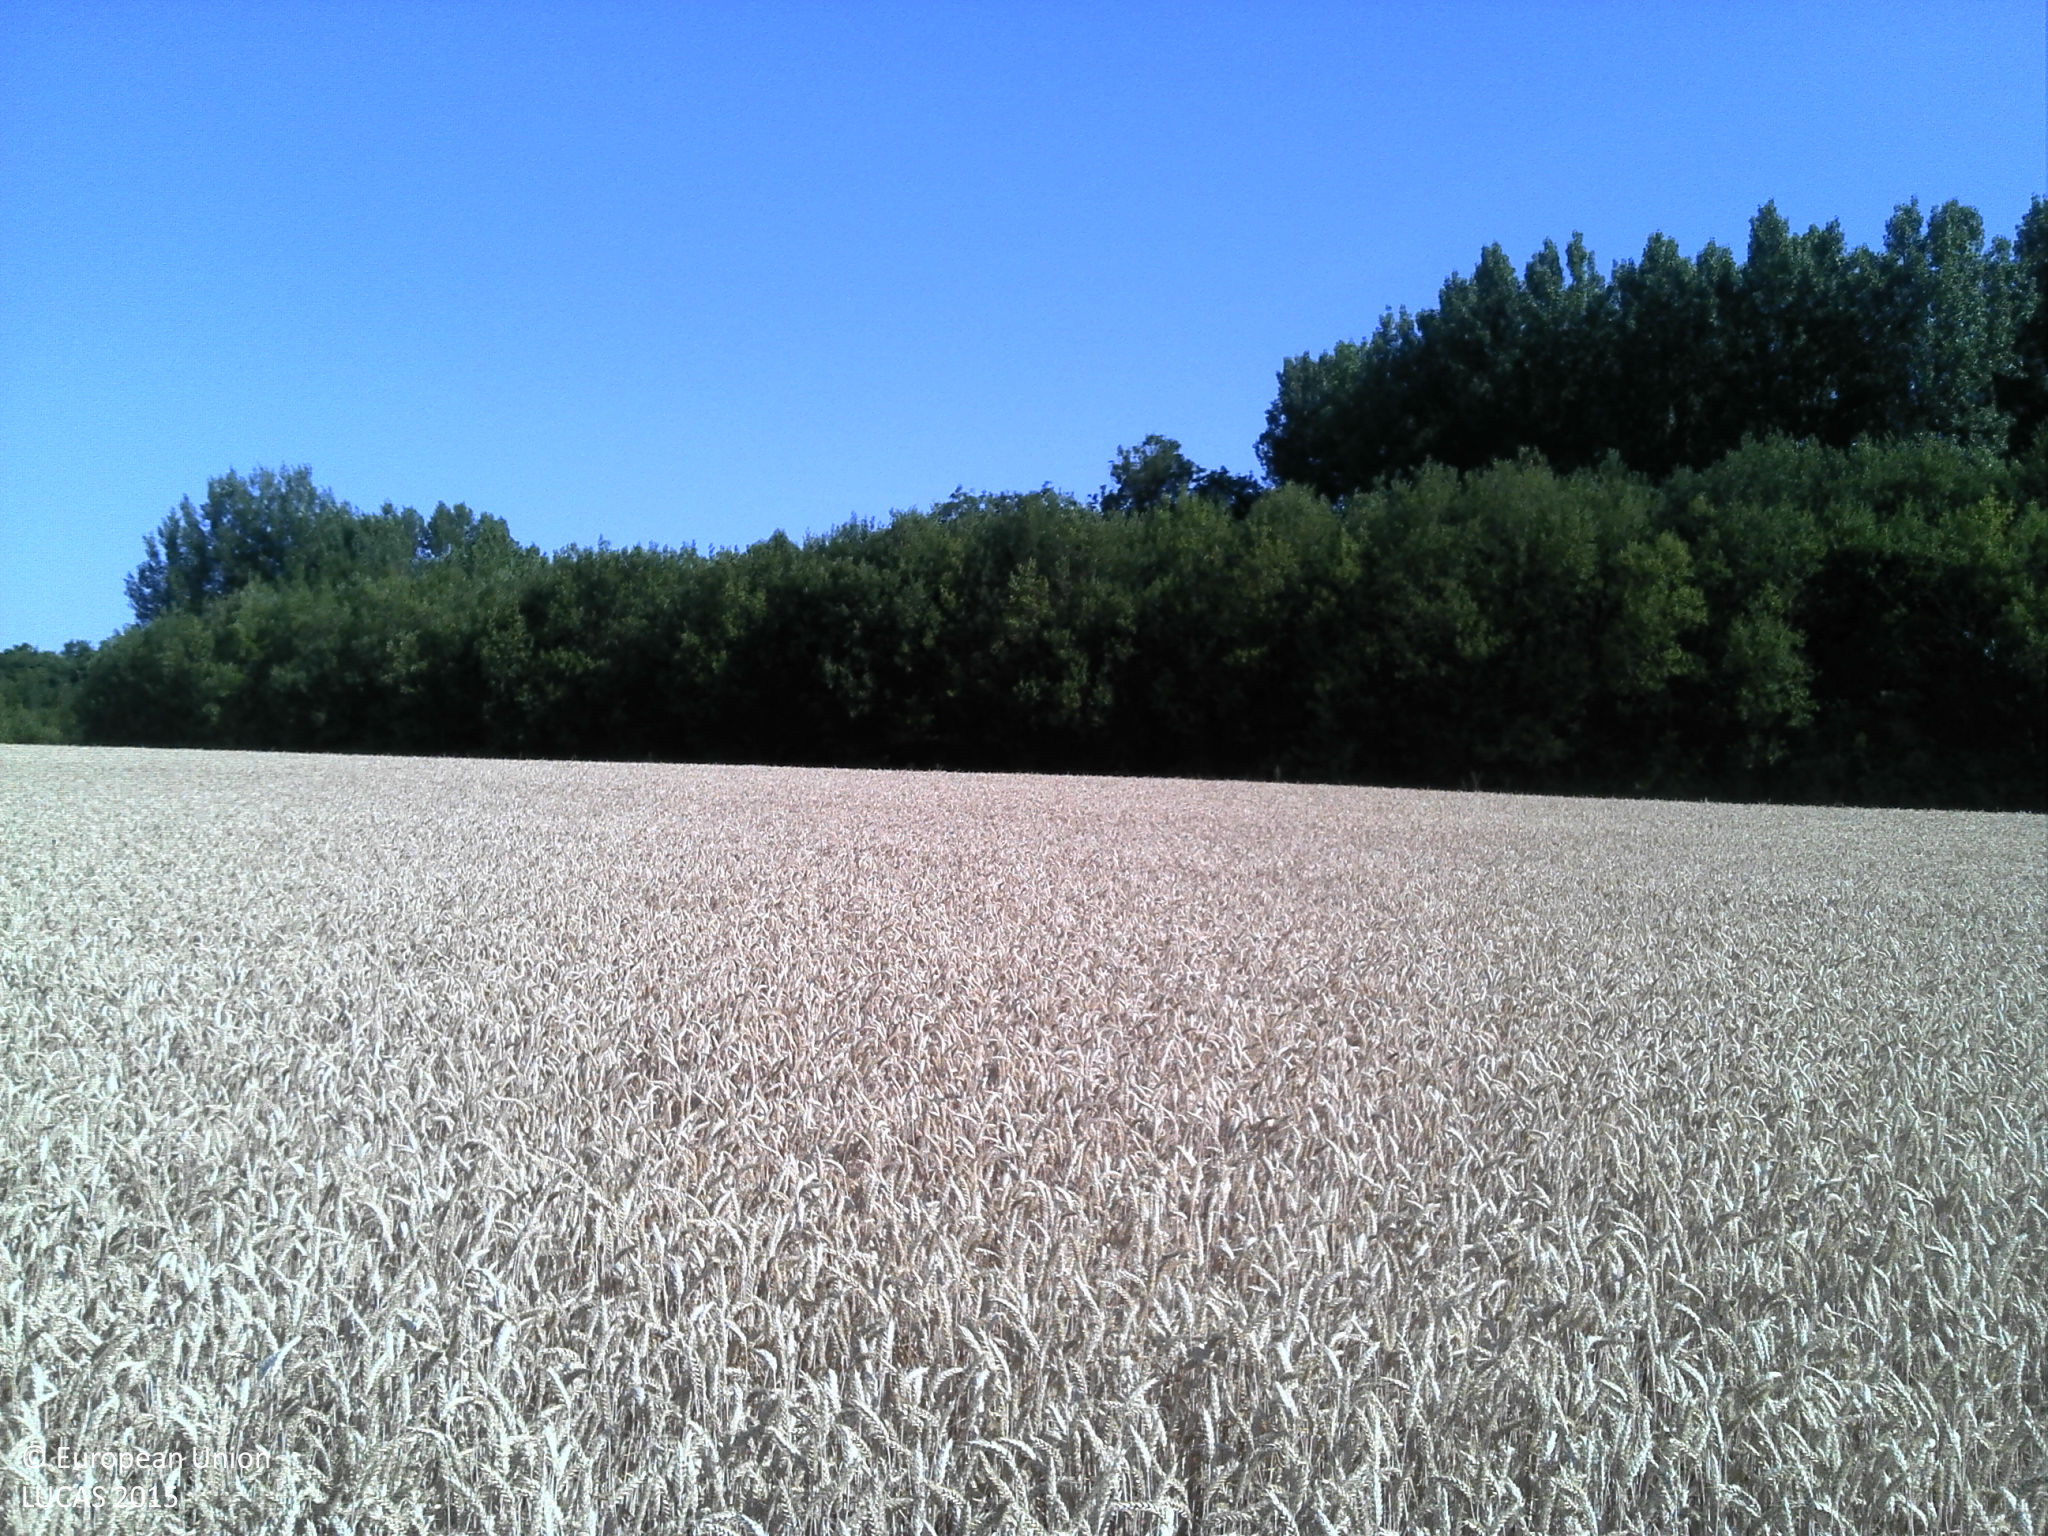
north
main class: Cropland
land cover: Common wheat
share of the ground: > 75 %
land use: Agriculture (excluding fallow land and kitchen gardens)
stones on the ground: < 10 %
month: July
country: FR
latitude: 49.4217
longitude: 4.1638
